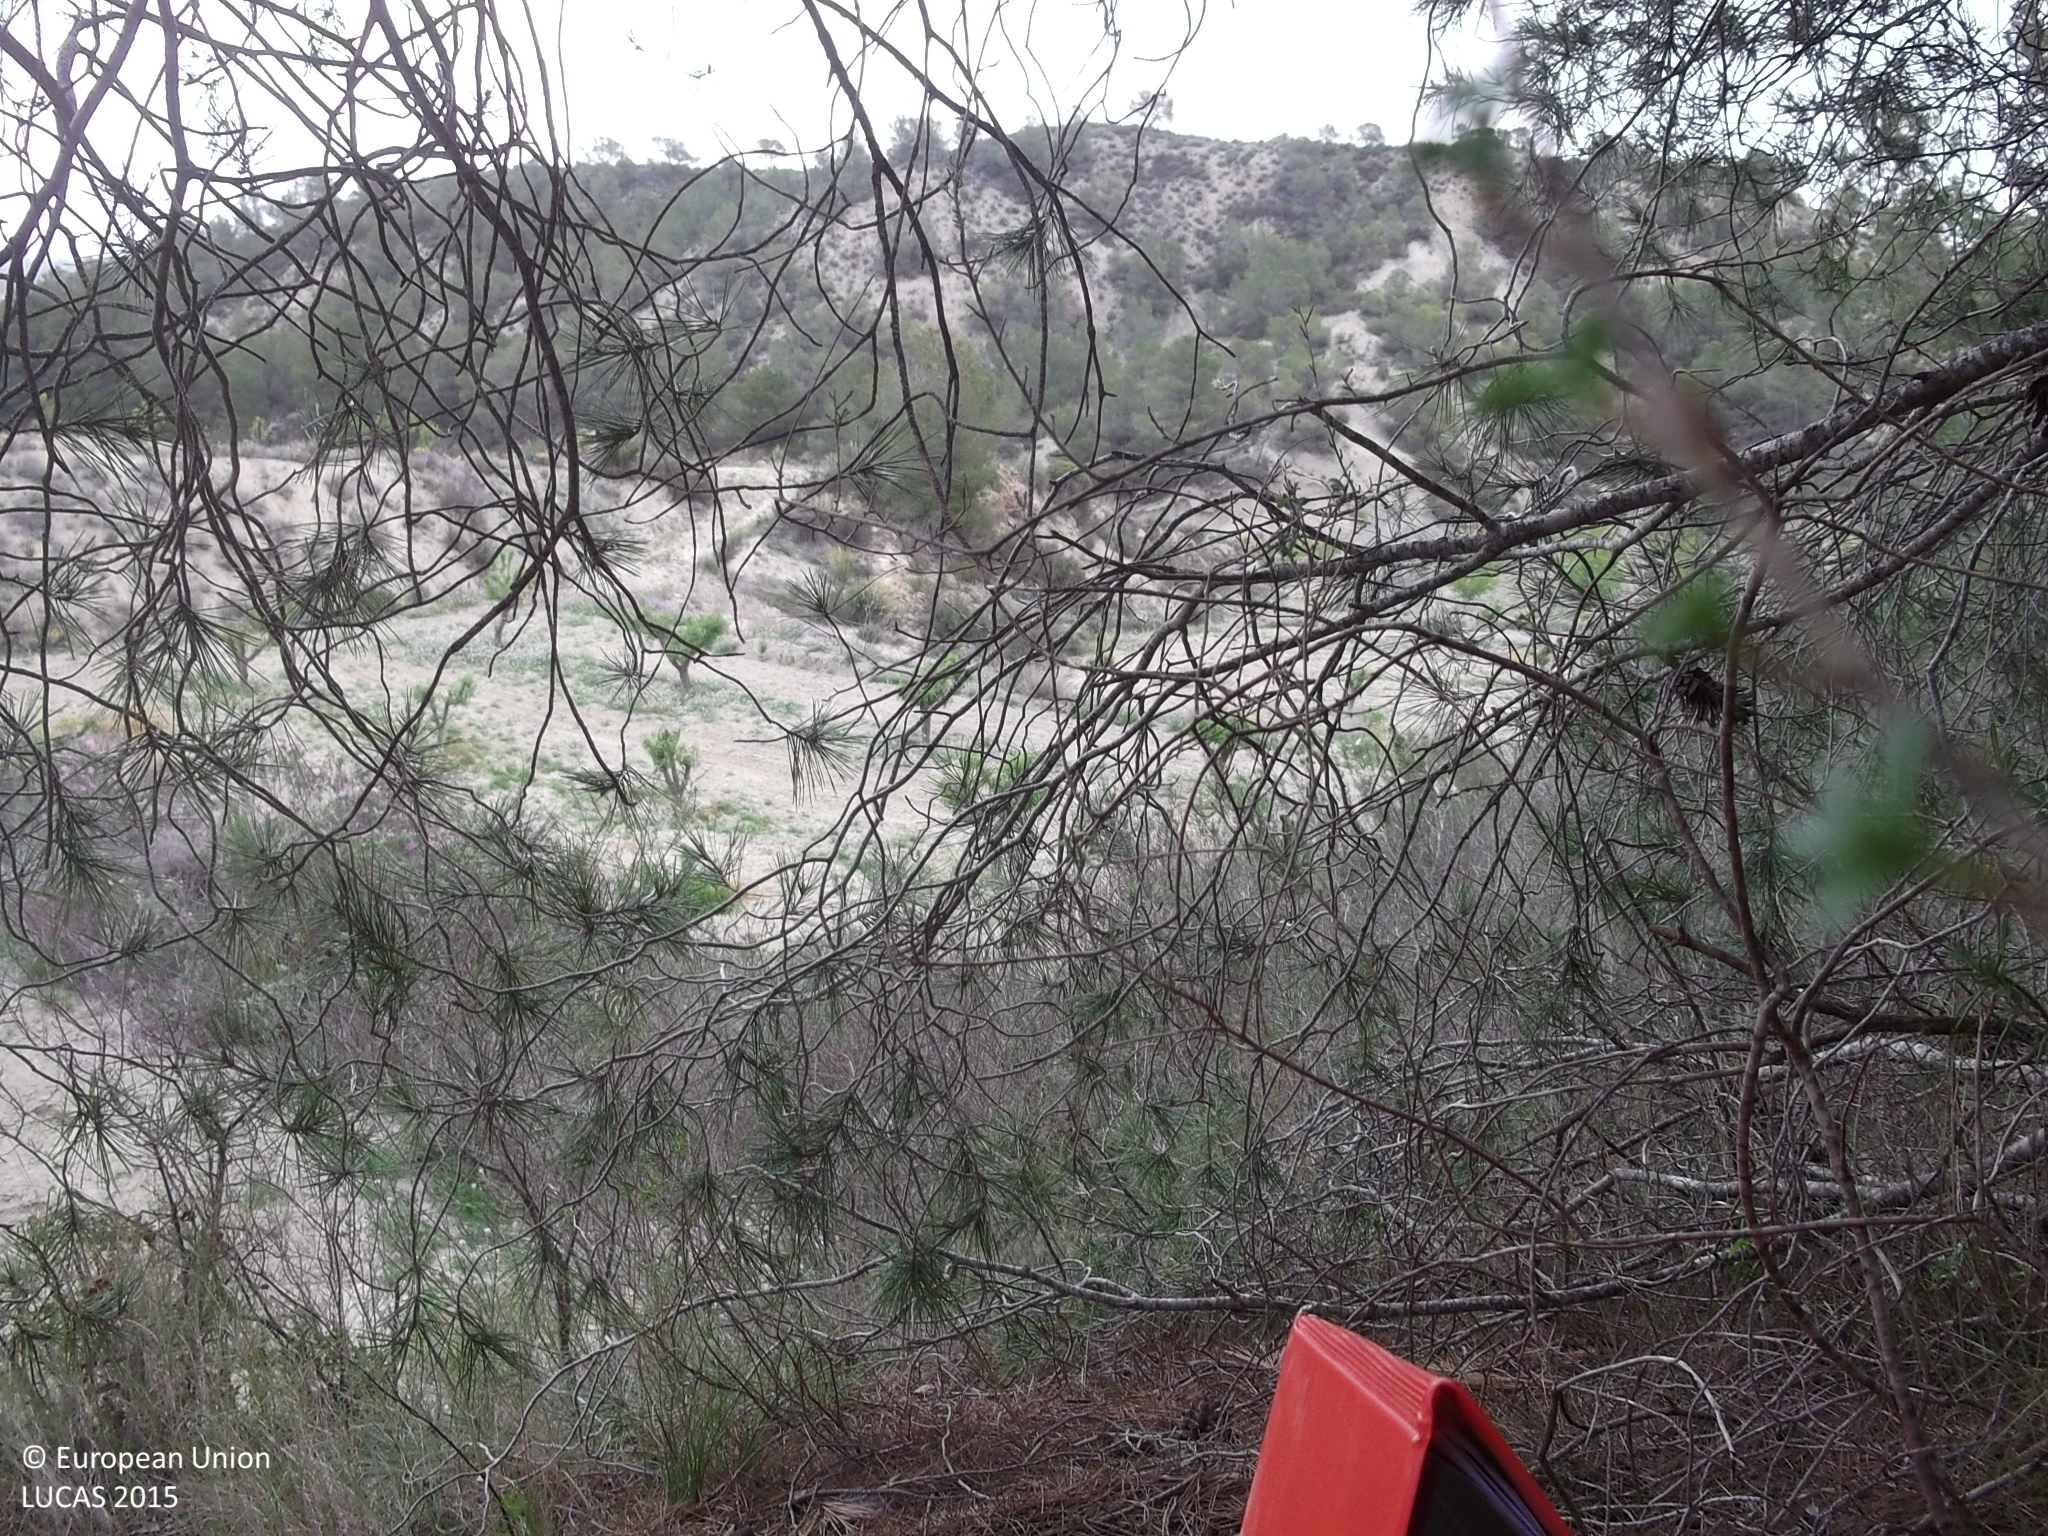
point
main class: Woodland
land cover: Pine dominated coniferous woodland
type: coniferous forest of the mediterranean region
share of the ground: 10 - 25 %
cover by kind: coniferous forest trees 50 %, shrubs 50 %
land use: Semi-natural and natural areas not in use
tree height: > 5 m
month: April
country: ES
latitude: 38.0060
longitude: -1.5917
